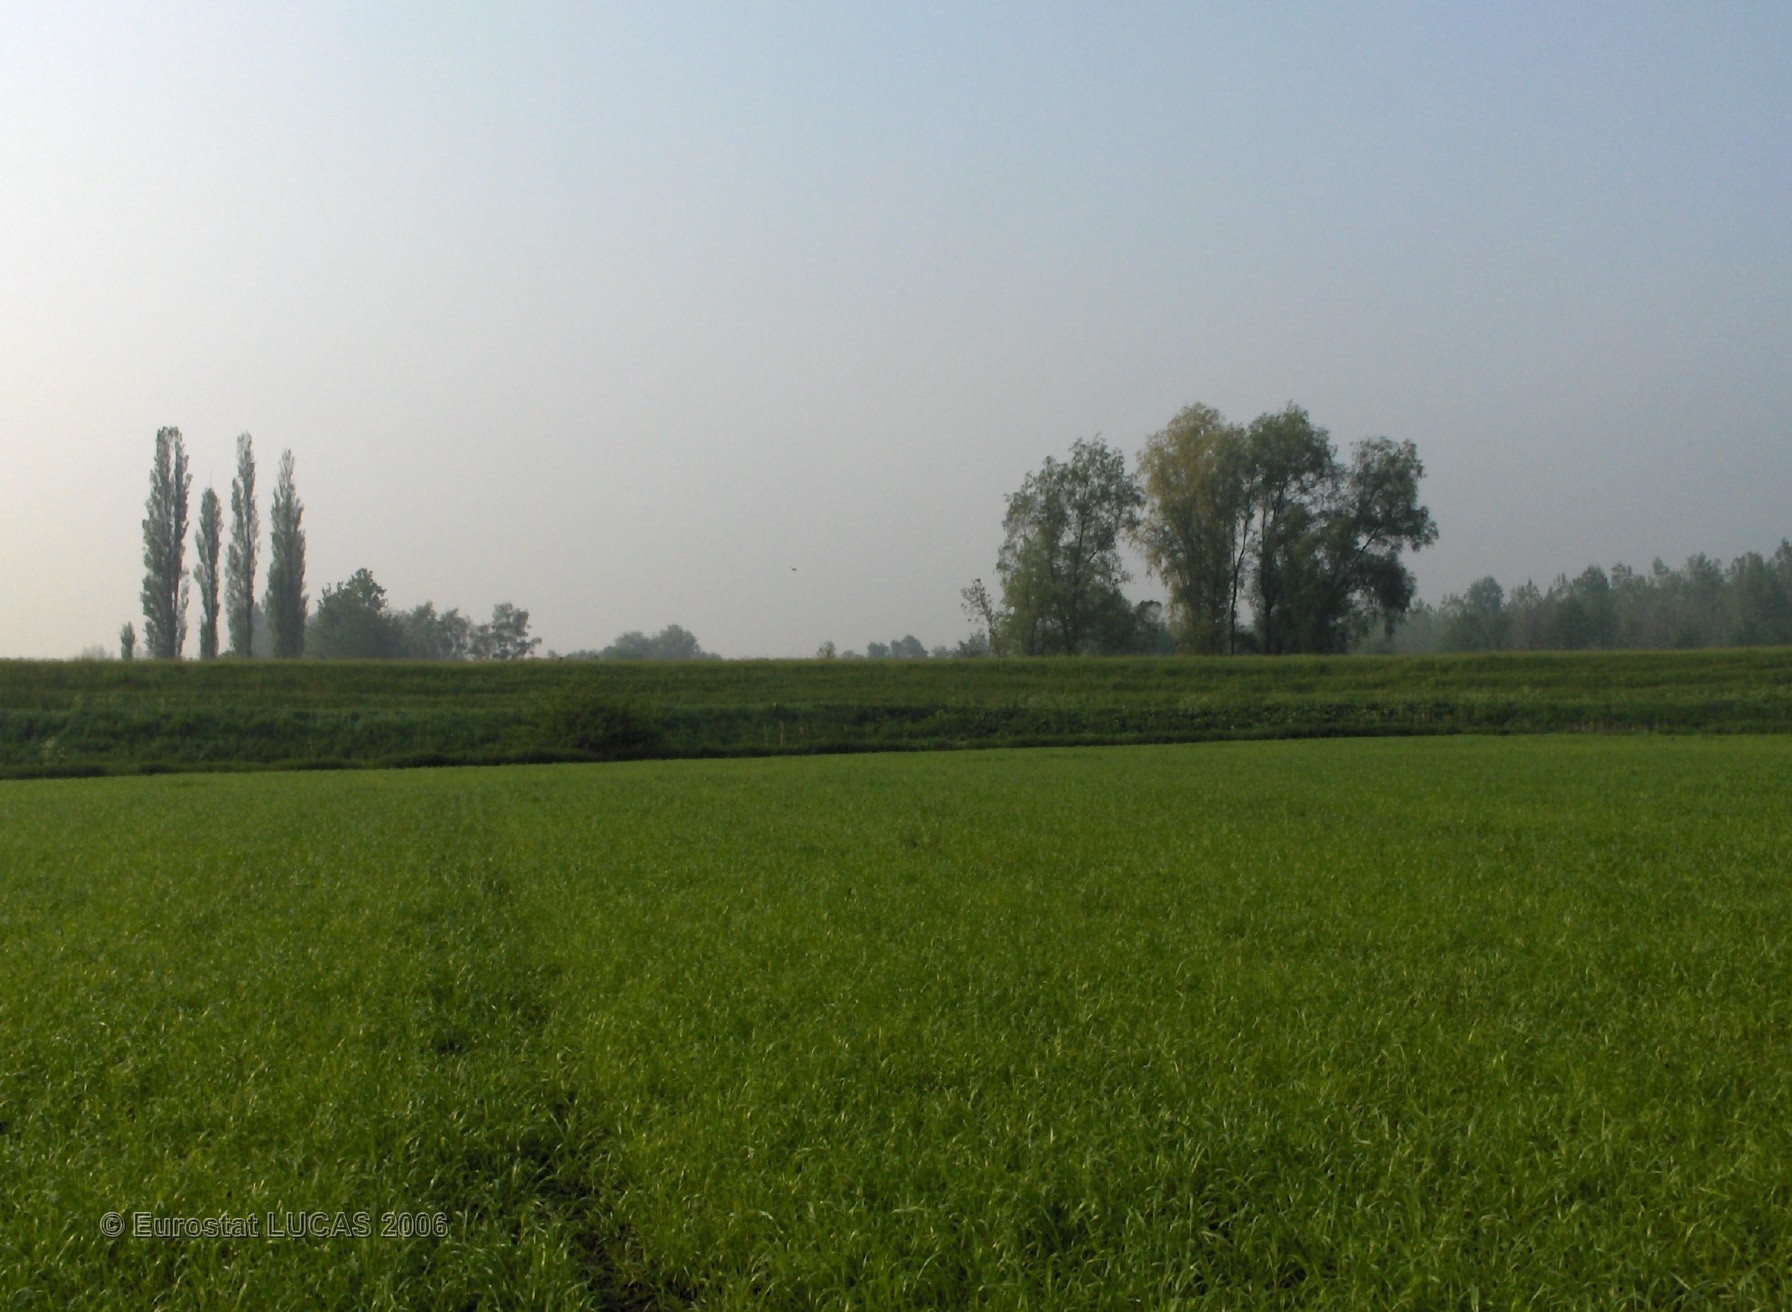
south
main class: Cropland
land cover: Triticale
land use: Agriculture (excluding fallow land and kitchen gardens)
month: May
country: BE
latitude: 51.0747
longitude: 4.4149
